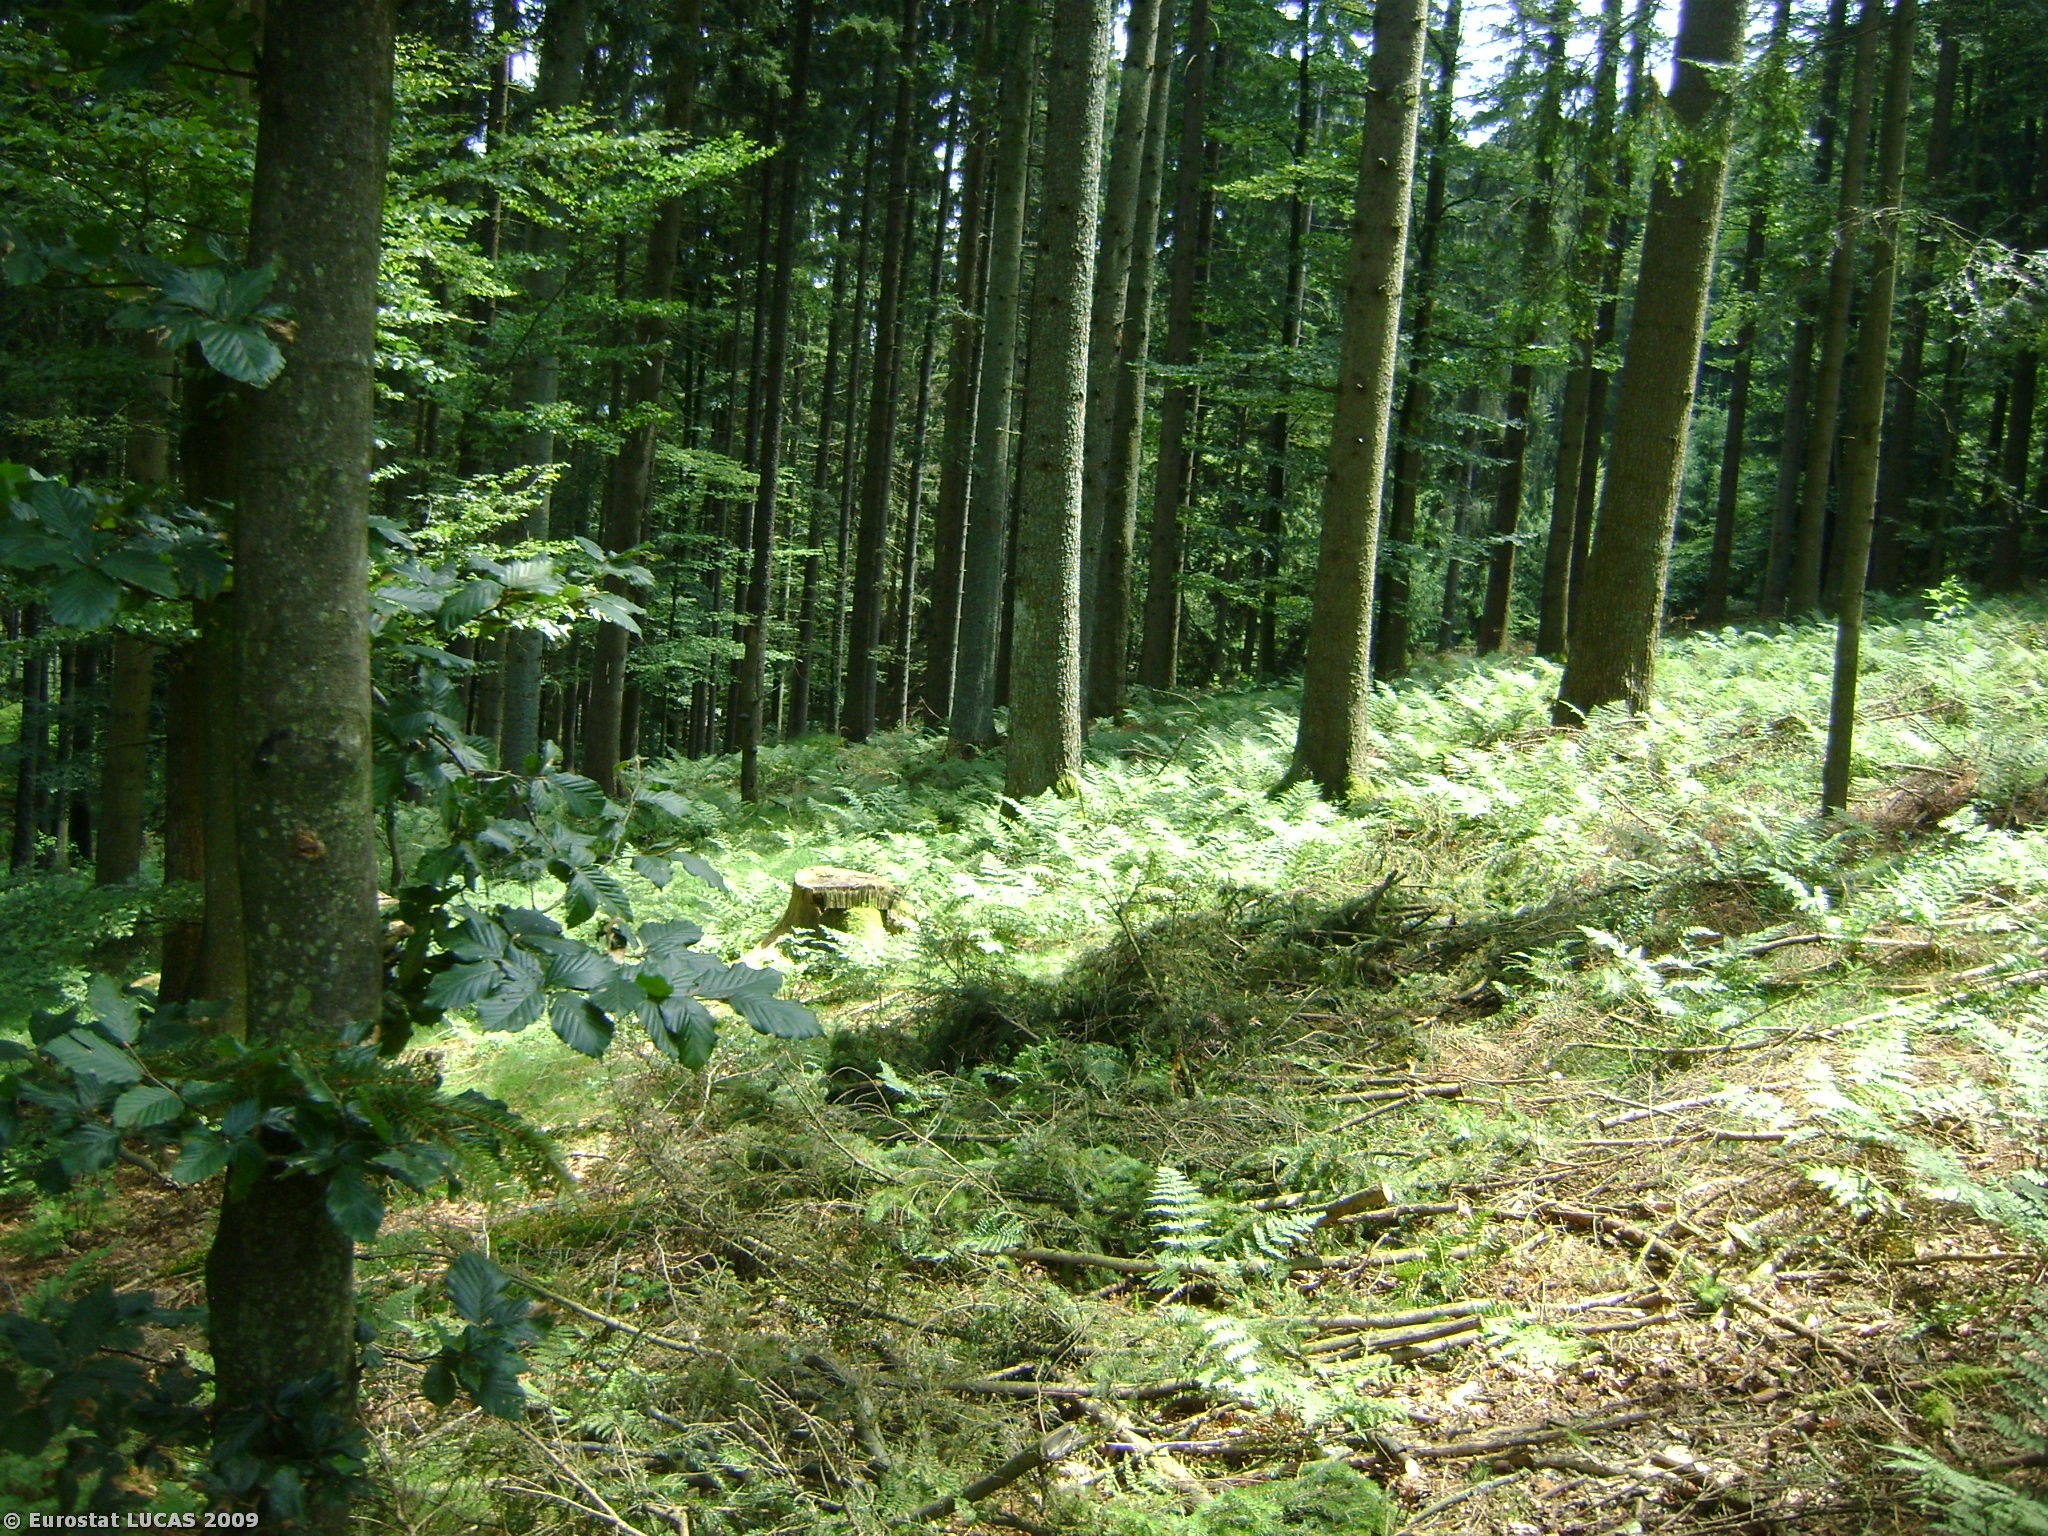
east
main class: Woodland
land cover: Mixed woodland
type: hemiboreal forest and nemoral coniferous forest and mixed broadleaved-coniferous forest
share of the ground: > 75 %
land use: Forestry
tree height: > 5 m
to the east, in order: Mixed woodland; Coniferous woodland; Tracks; Coniferous woodland
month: July
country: AT
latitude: 48.0950
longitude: 13.5305
